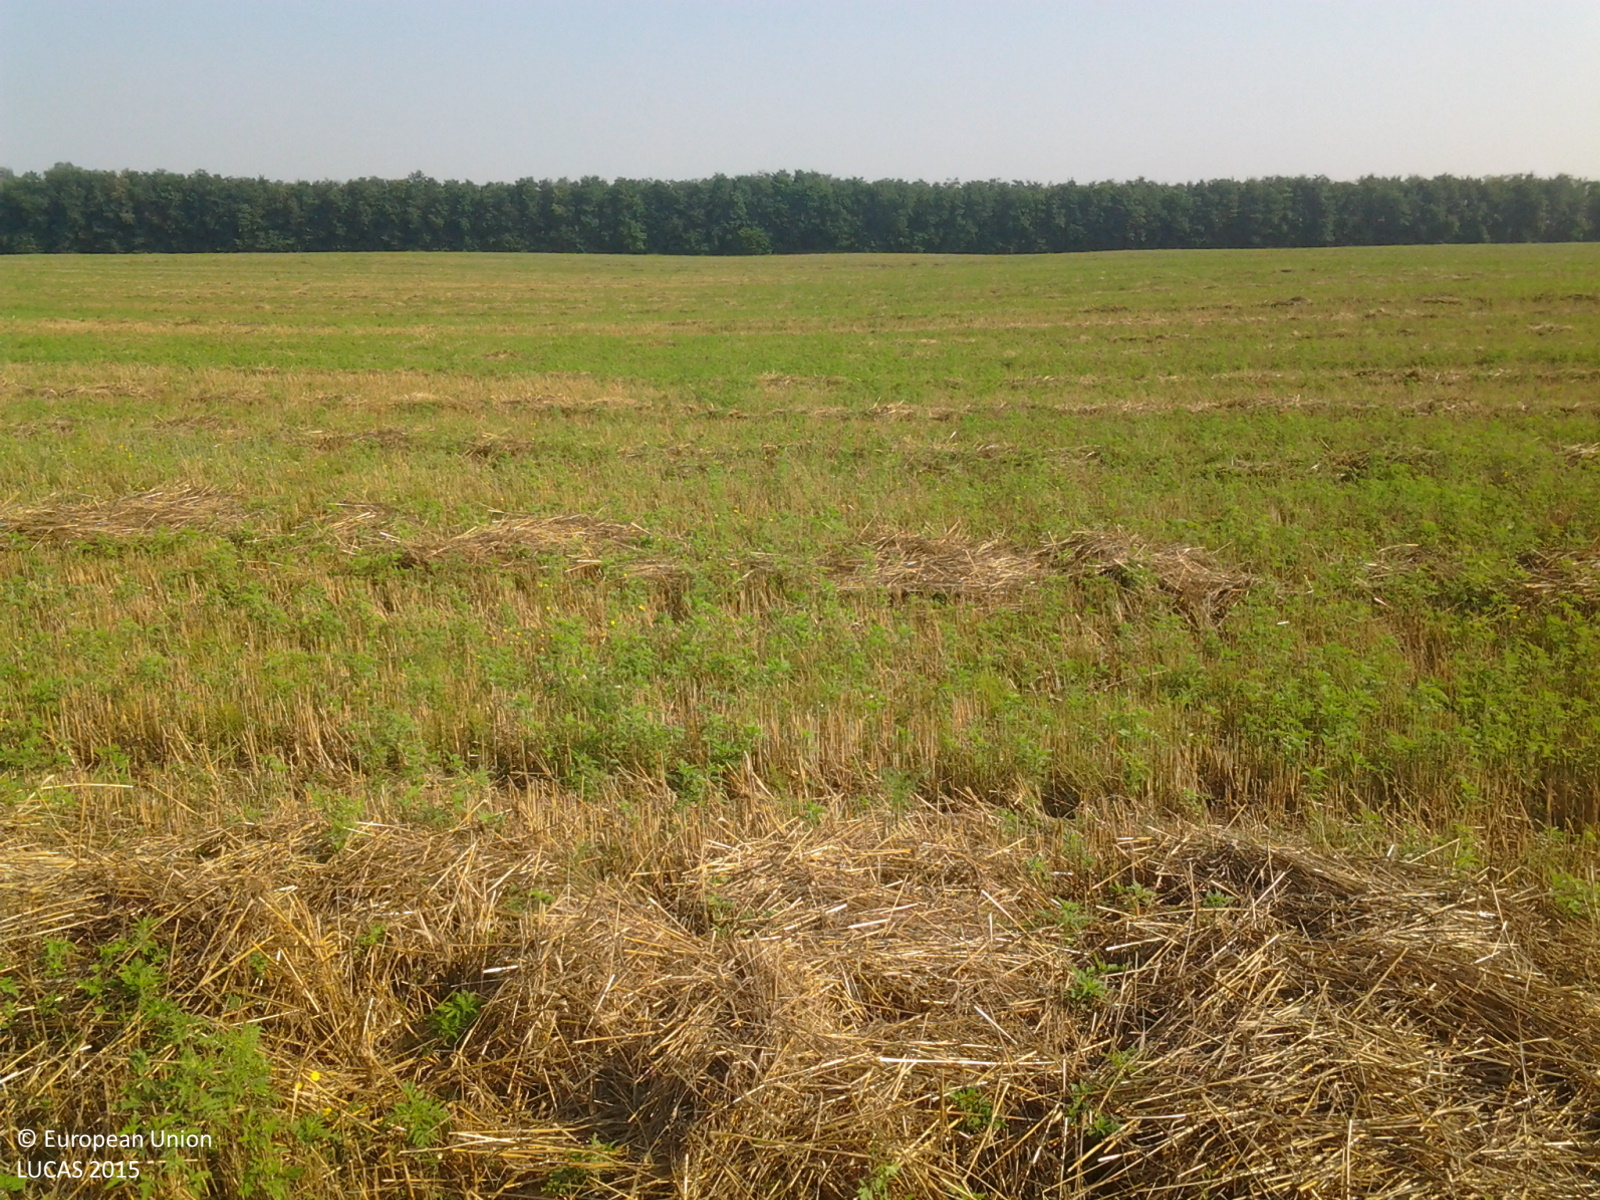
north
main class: Cropland
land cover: Durum wheat
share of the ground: 10 - 25 %
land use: Agriculture (excluding fallow land and kitchen gardens)
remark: Harvested field
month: August
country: HU
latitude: 46.3968
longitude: 18.2148
